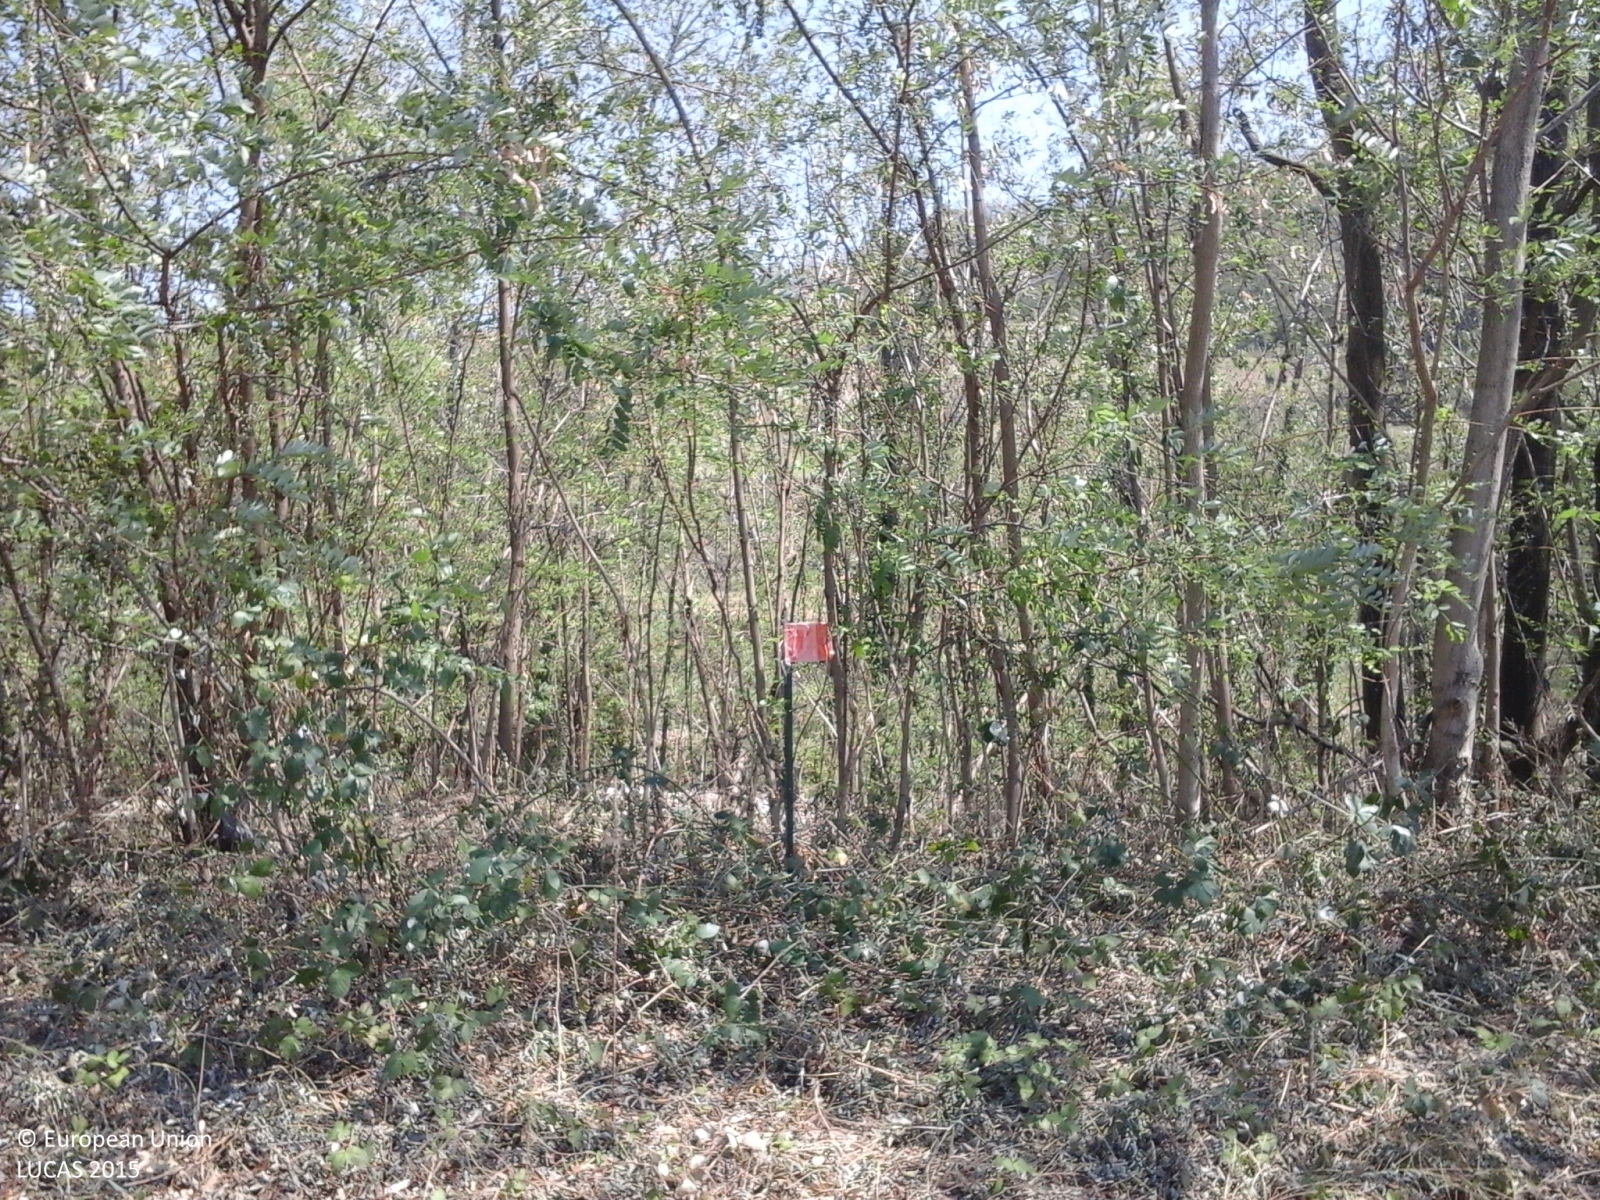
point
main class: Woodland
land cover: Broadleaved woodland
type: mesophytic deciduous forest
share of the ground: > 75 %
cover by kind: broadleaved forest trees 100 %
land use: Semi-natural and natural areas not in use
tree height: > 5 m
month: May
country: IT
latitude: 44.4912
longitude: 10.8658
